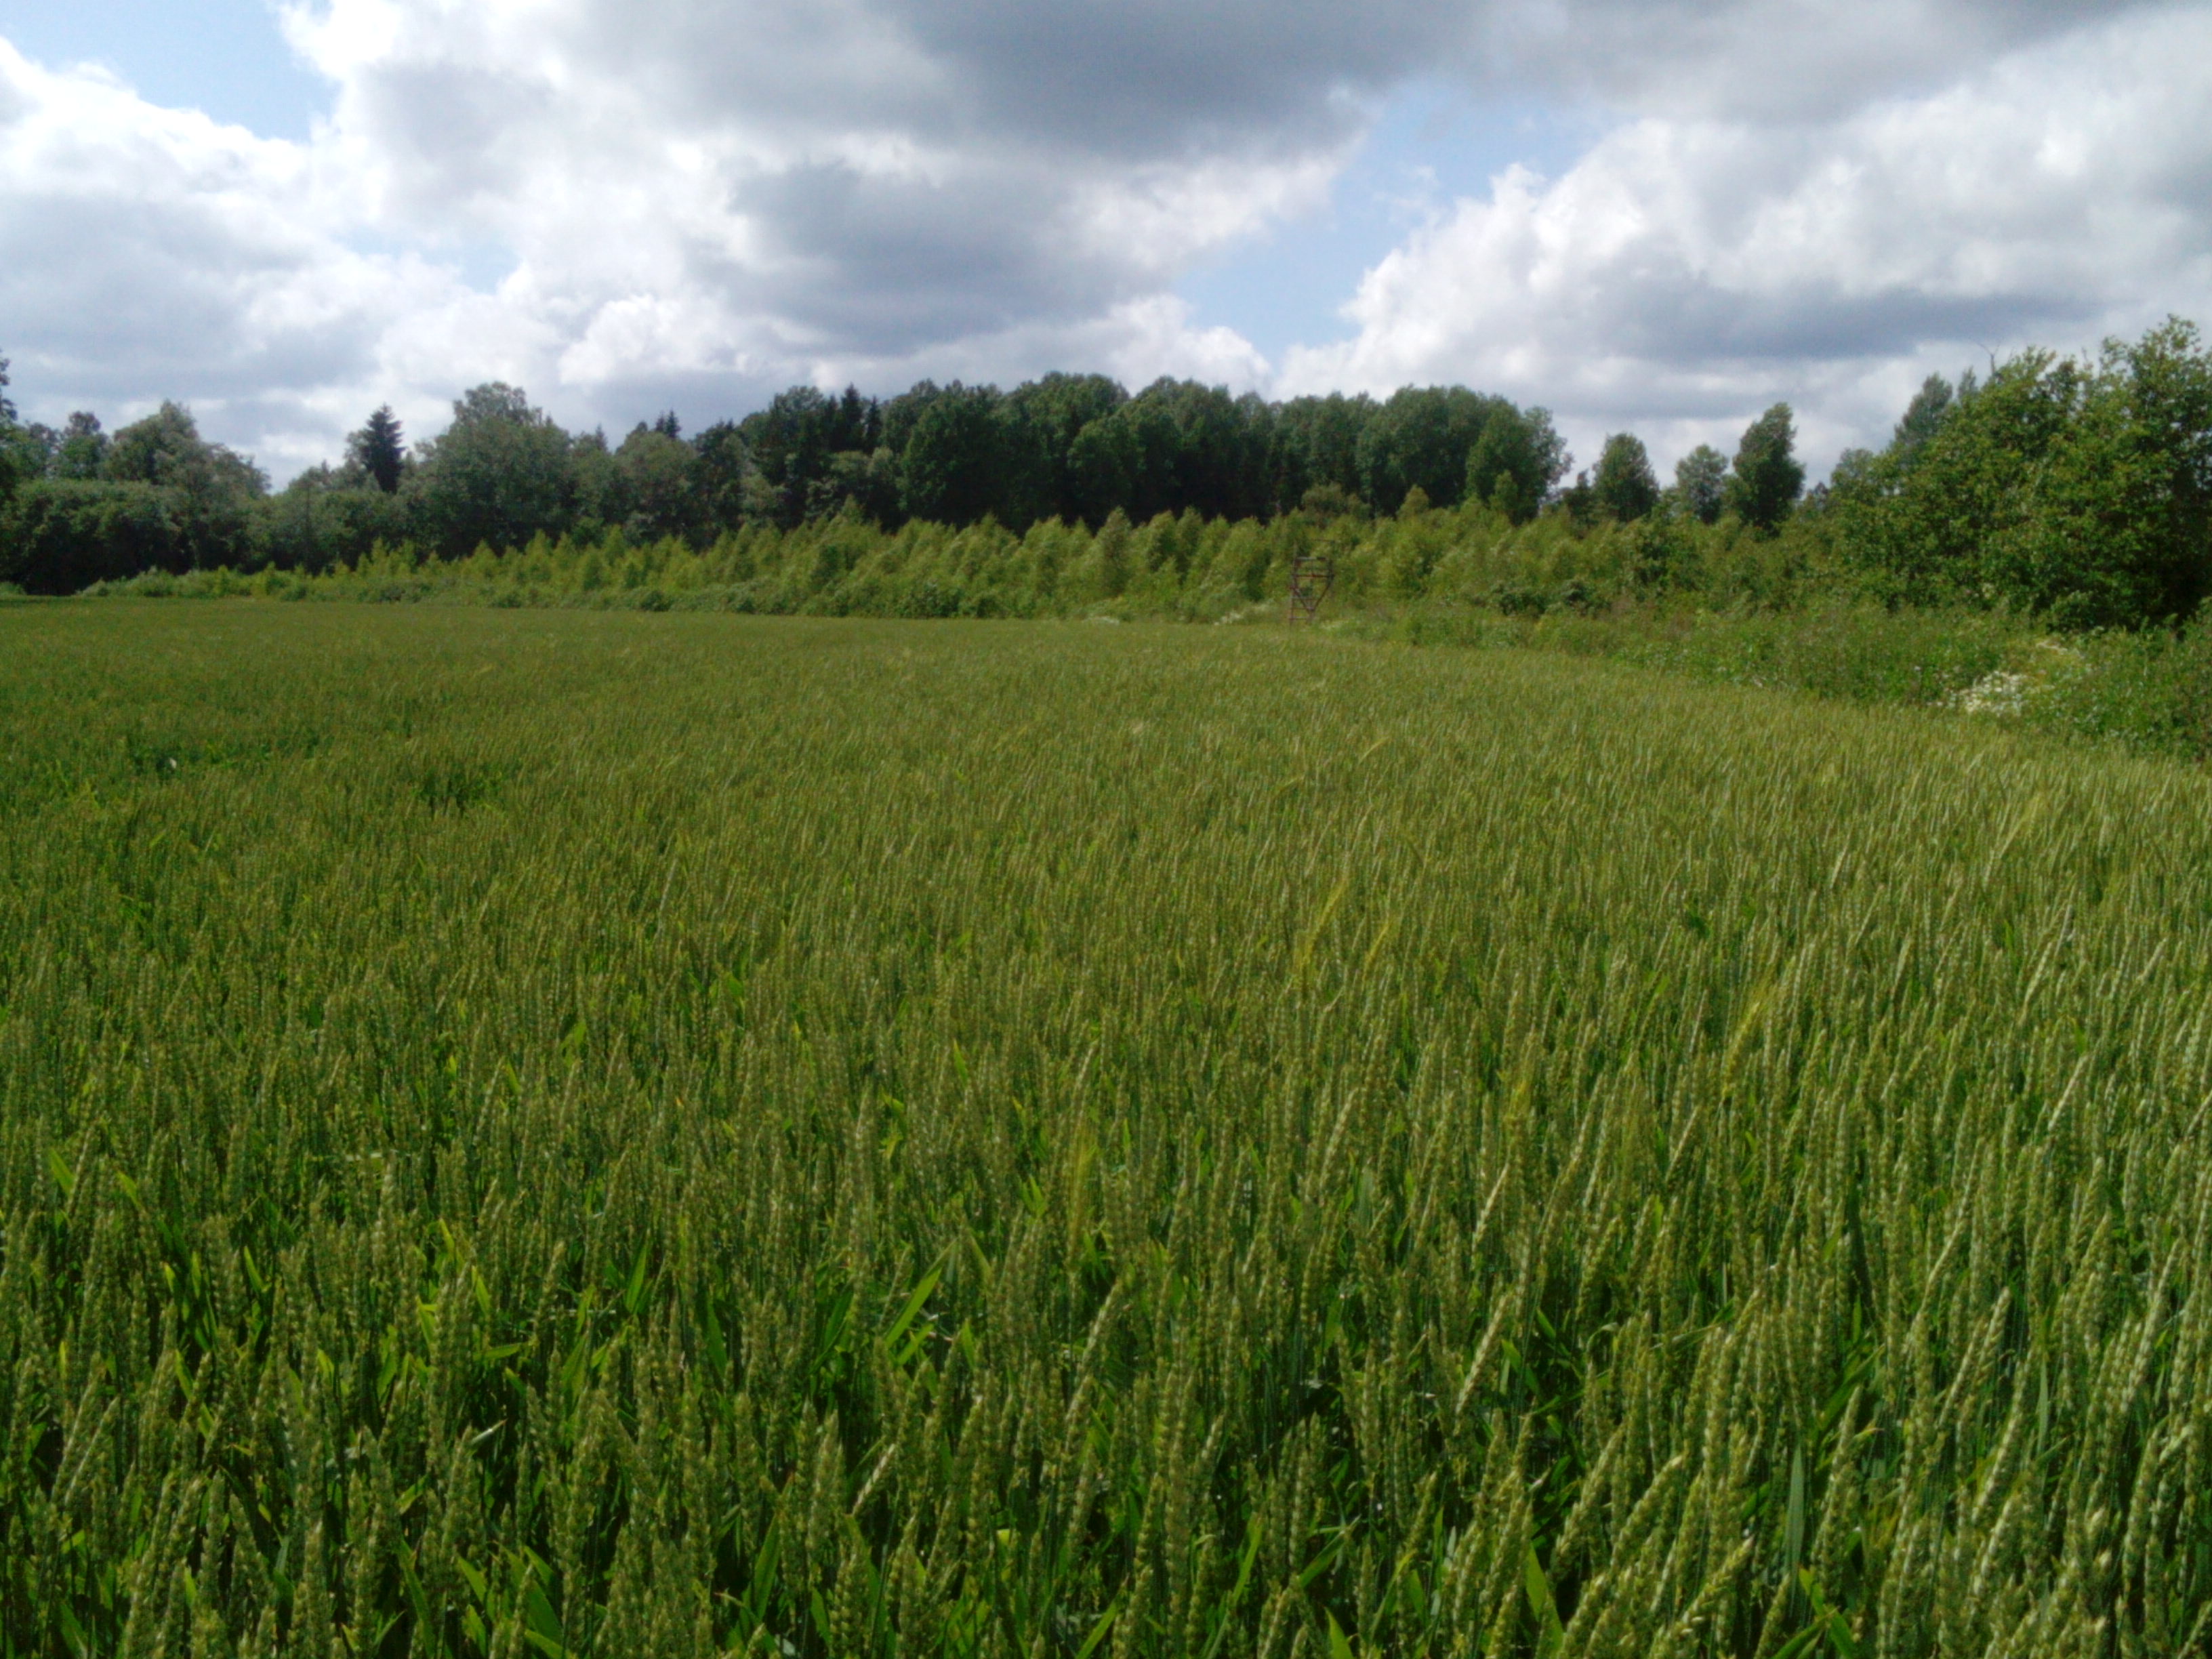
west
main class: Cropland
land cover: Common wheat
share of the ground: > 75 %
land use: Agriculture (excluding fallow land and kitchen gardens)
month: July
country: LV
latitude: 56.9560
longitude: 22.3358
